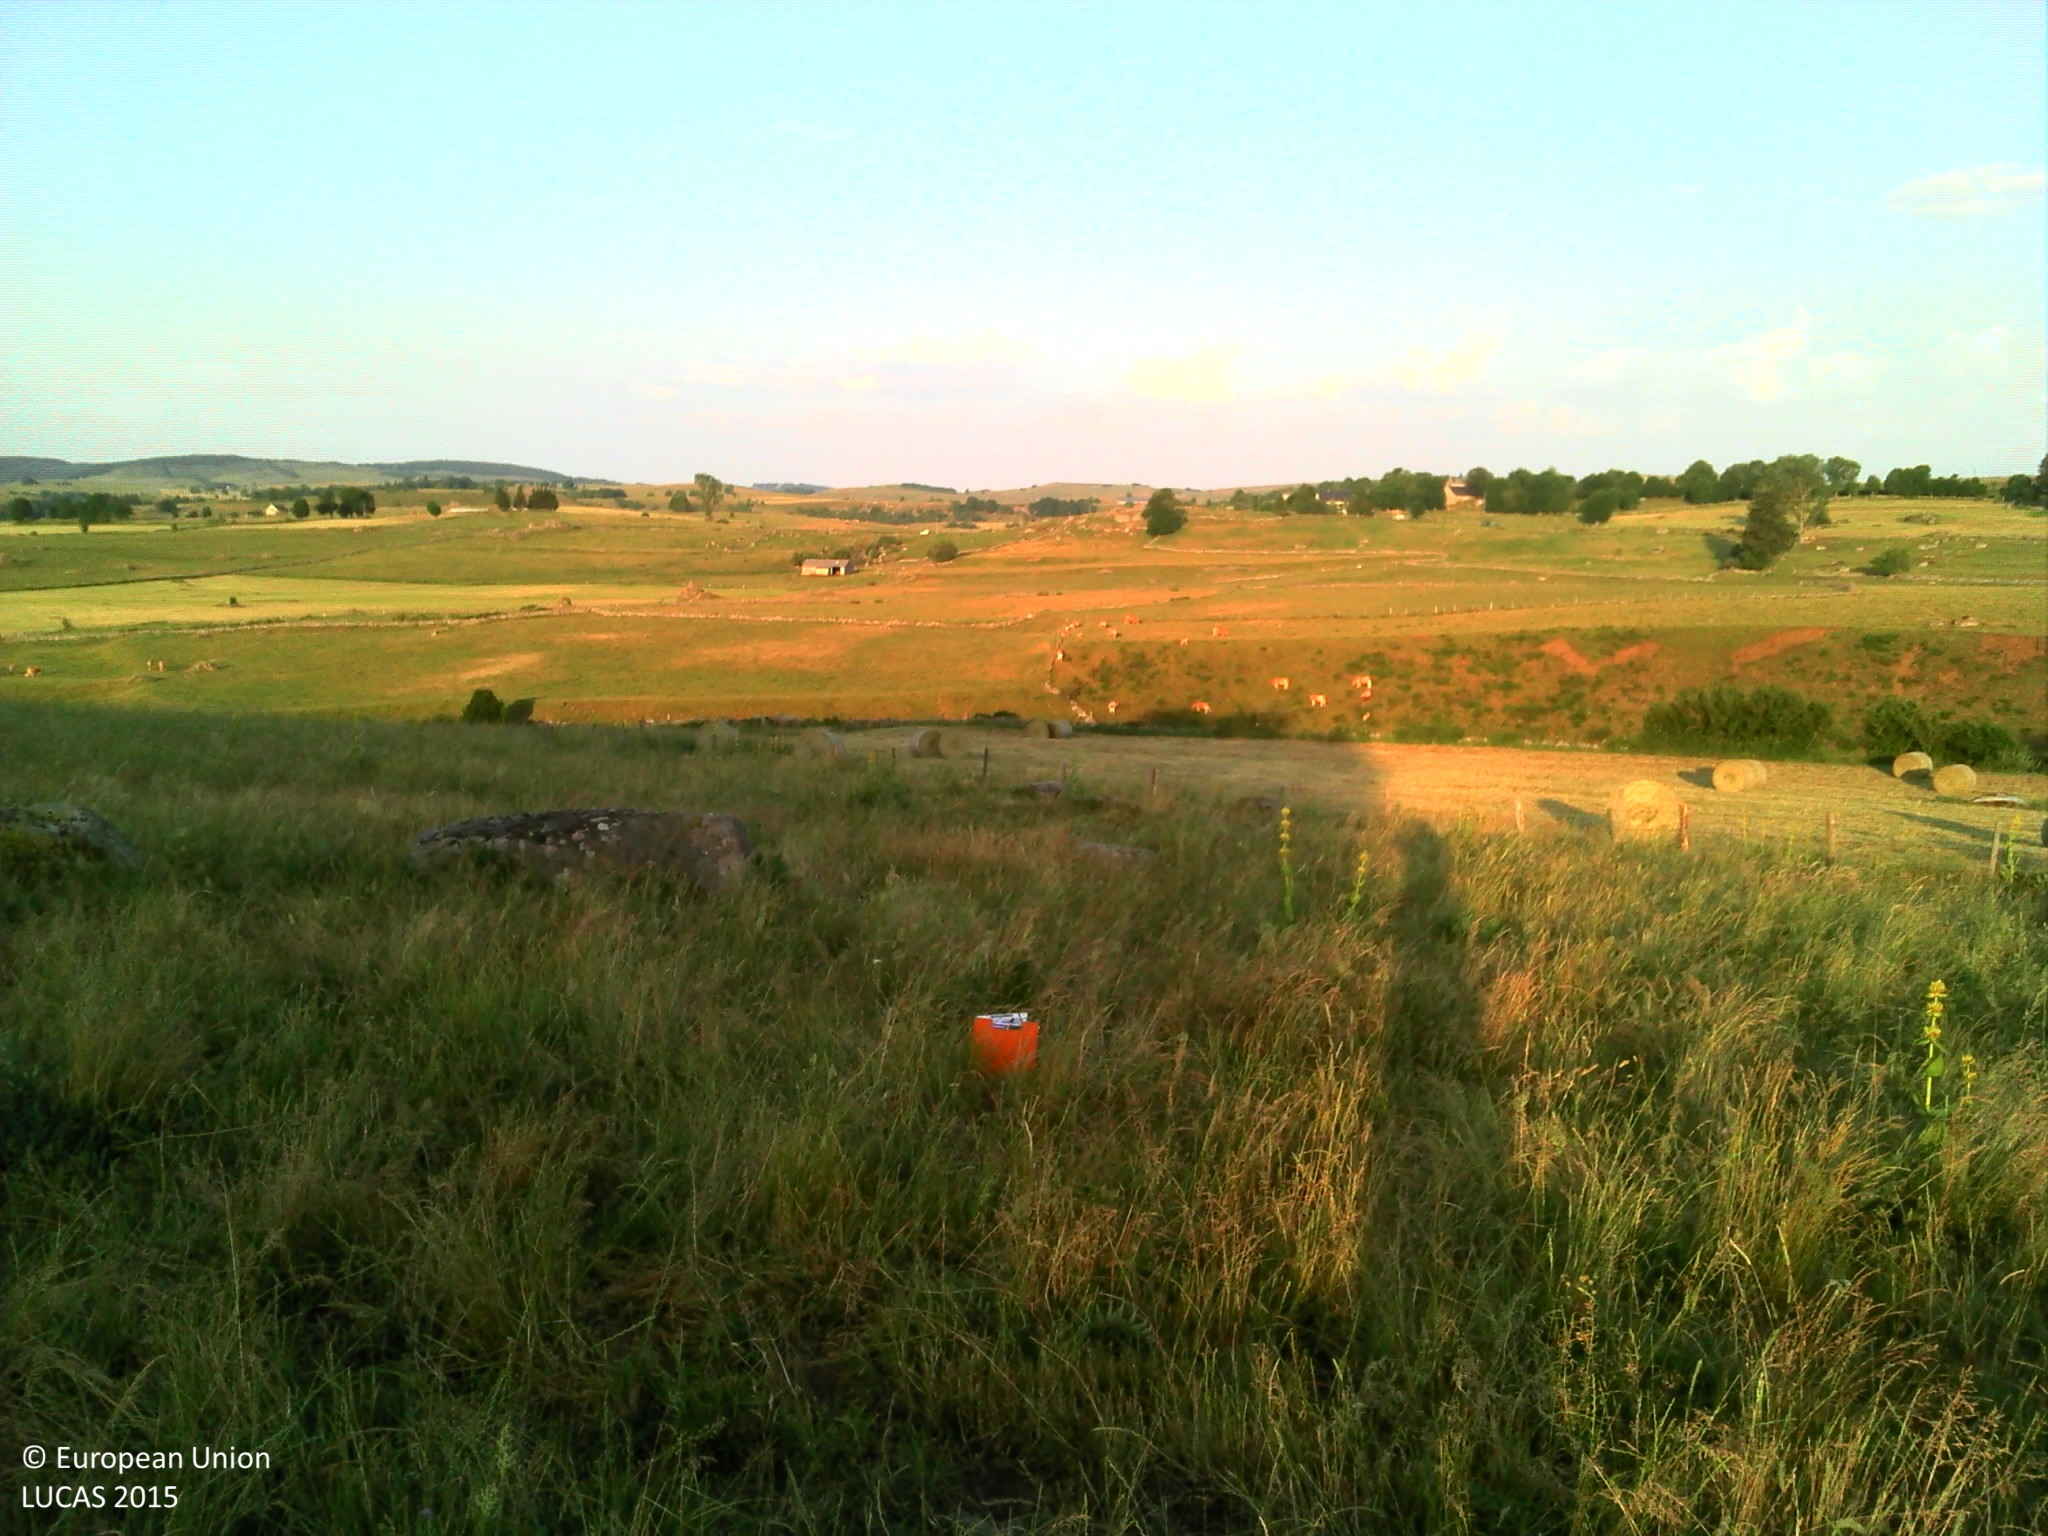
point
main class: Grassland
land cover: Grassland without tree/shrub cover
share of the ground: > 75 %
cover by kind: herbaceous plants 100 %
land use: Agriculture (excluding fallow land and kitchen gardens)
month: July
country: FR
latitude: 44.7306
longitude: 3.0206
